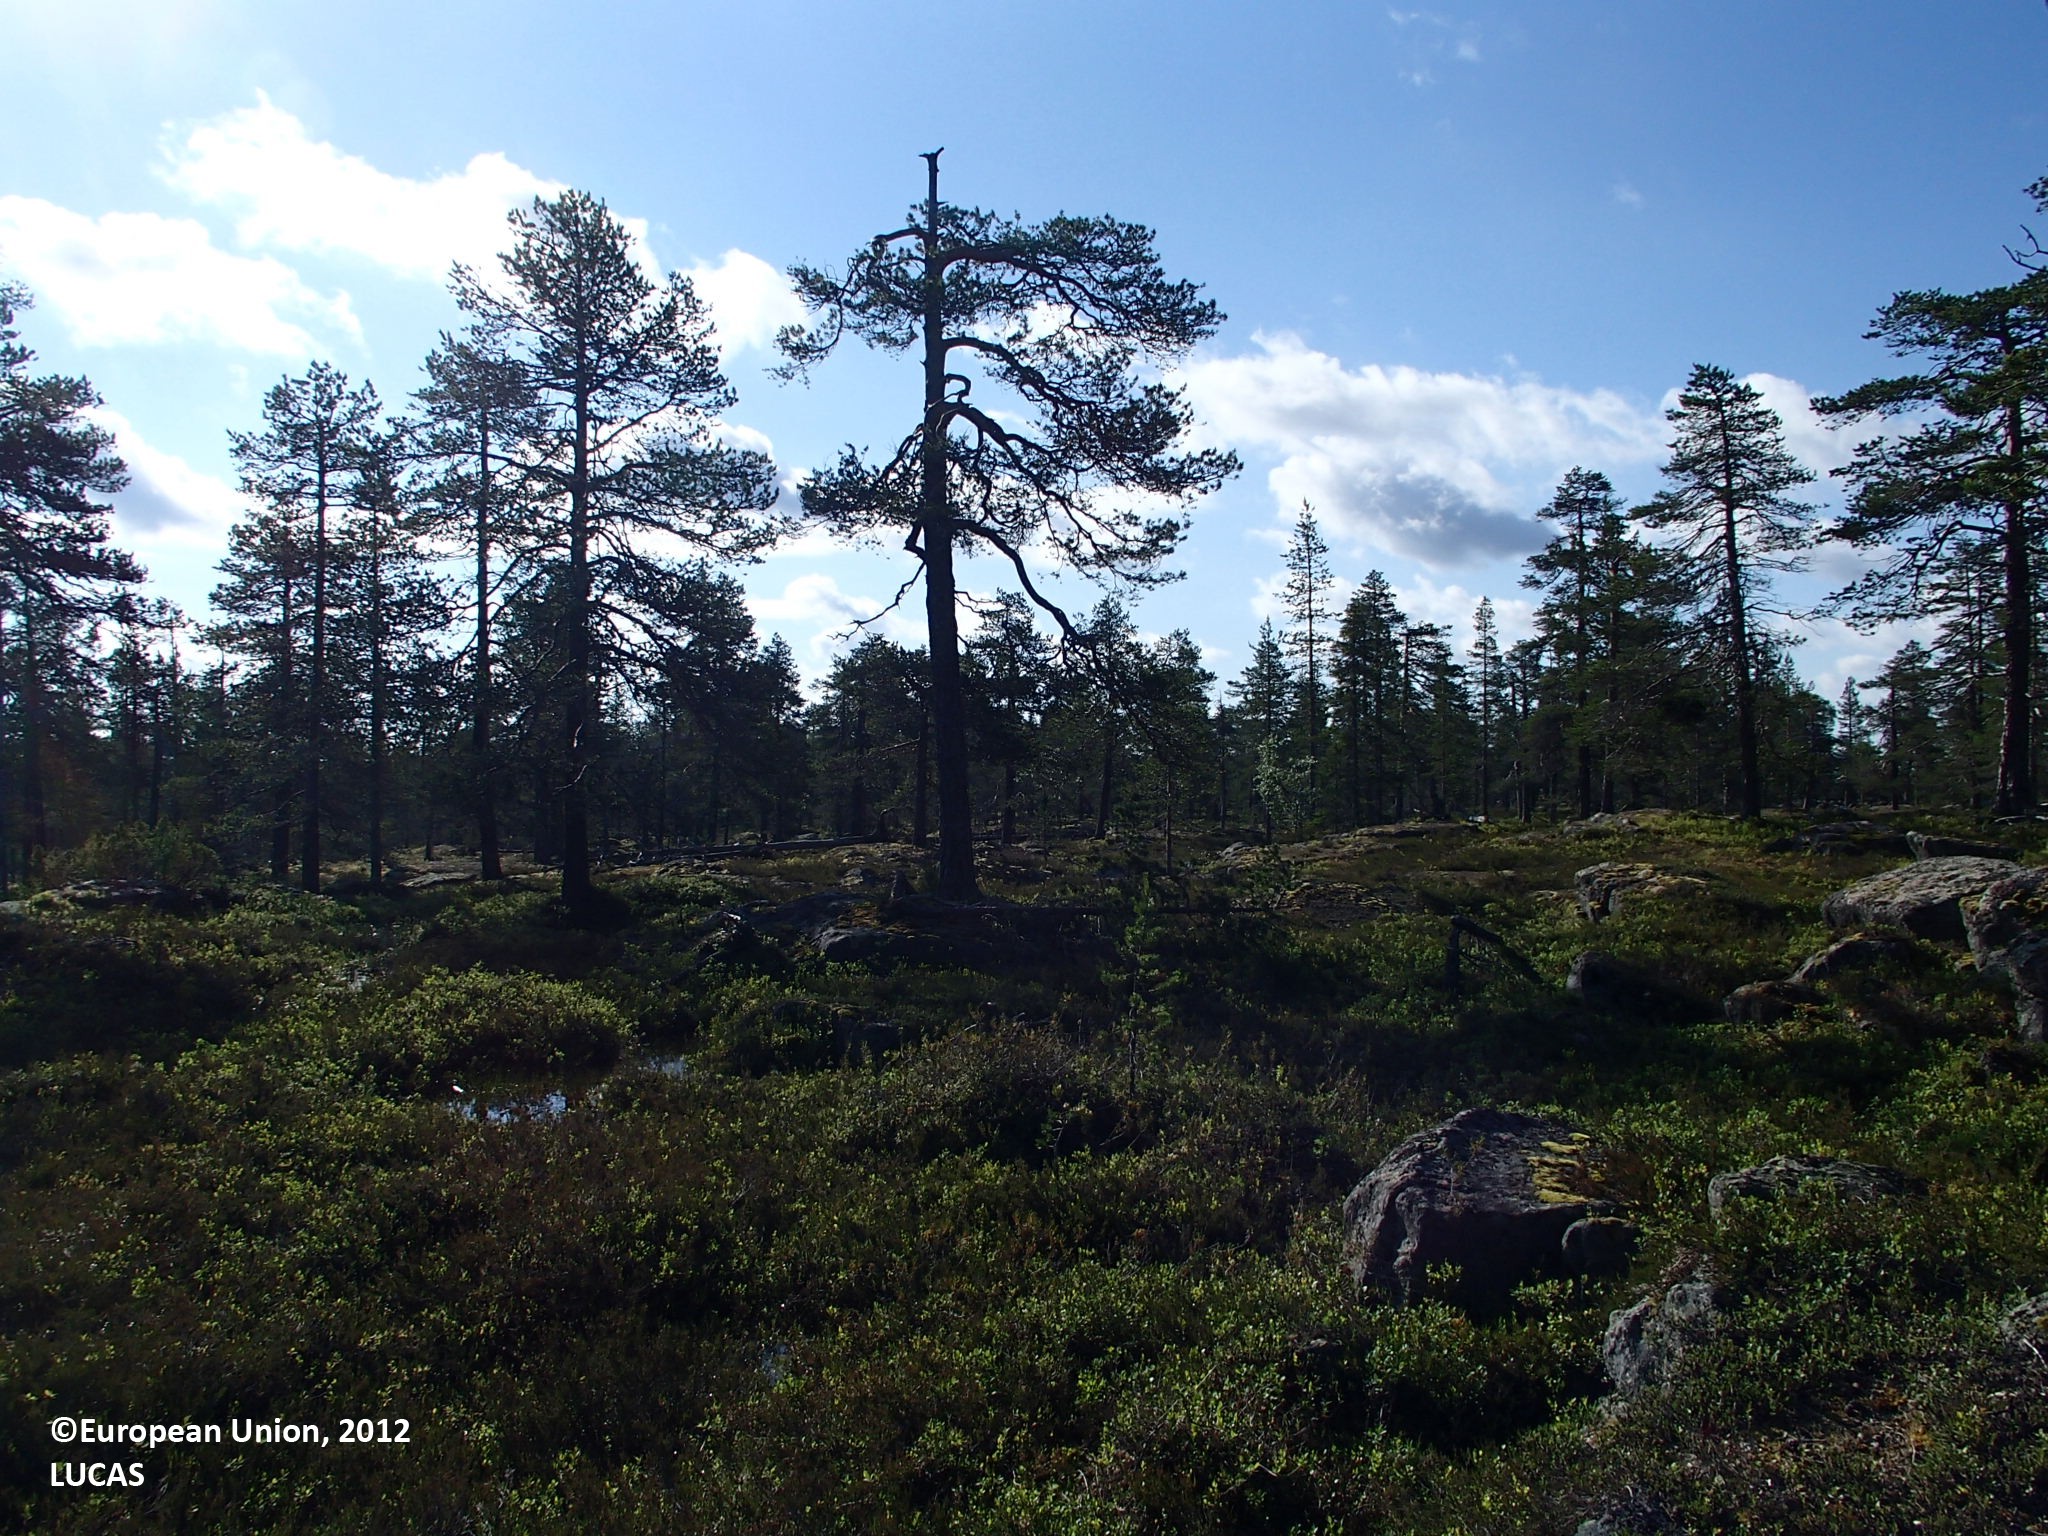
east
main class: Woodland
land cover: Pine dominated coniferous woodland
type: boreal forest
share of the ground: 10 - 25 %
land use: Forestry
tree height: > 5 m
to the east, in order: Pine dominated coniferous woodland
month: July
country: FI
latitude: 66.9102
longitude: 26.6510
